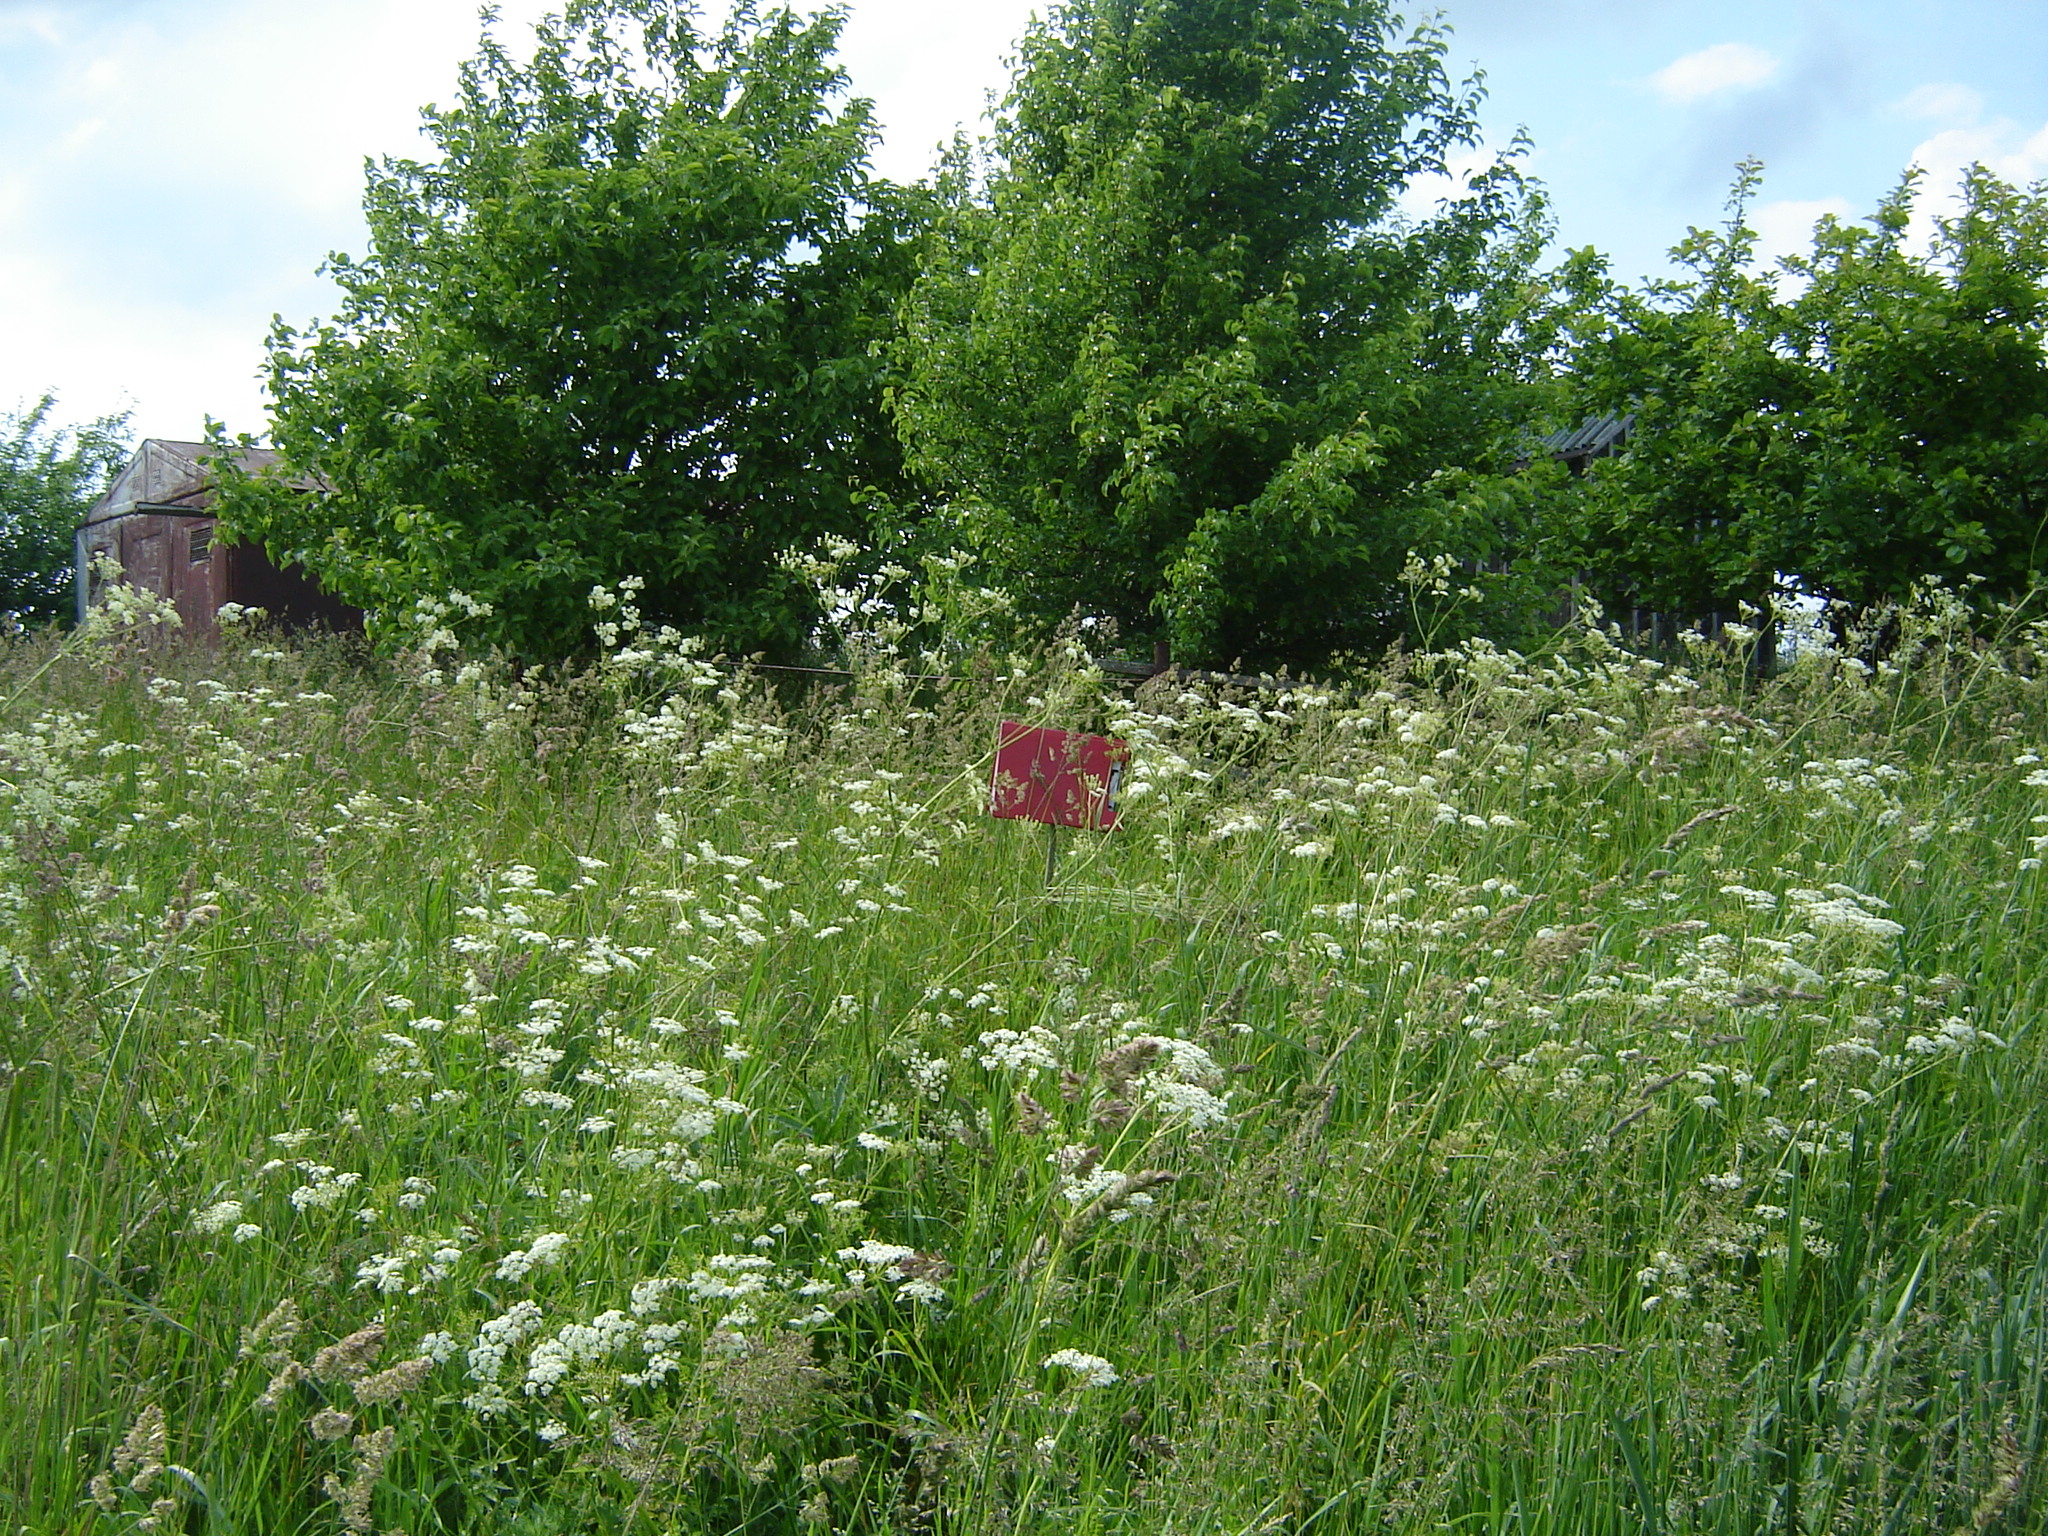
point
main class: Grassland
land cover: Grassland without tree/shrub cover
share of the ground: > 75 %
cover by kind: herbaceous plants 100 %
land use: Agriculture (excluding fallow land and kitchen gardens)
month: June
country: LT
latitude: 55.4776
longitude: 25.4870
